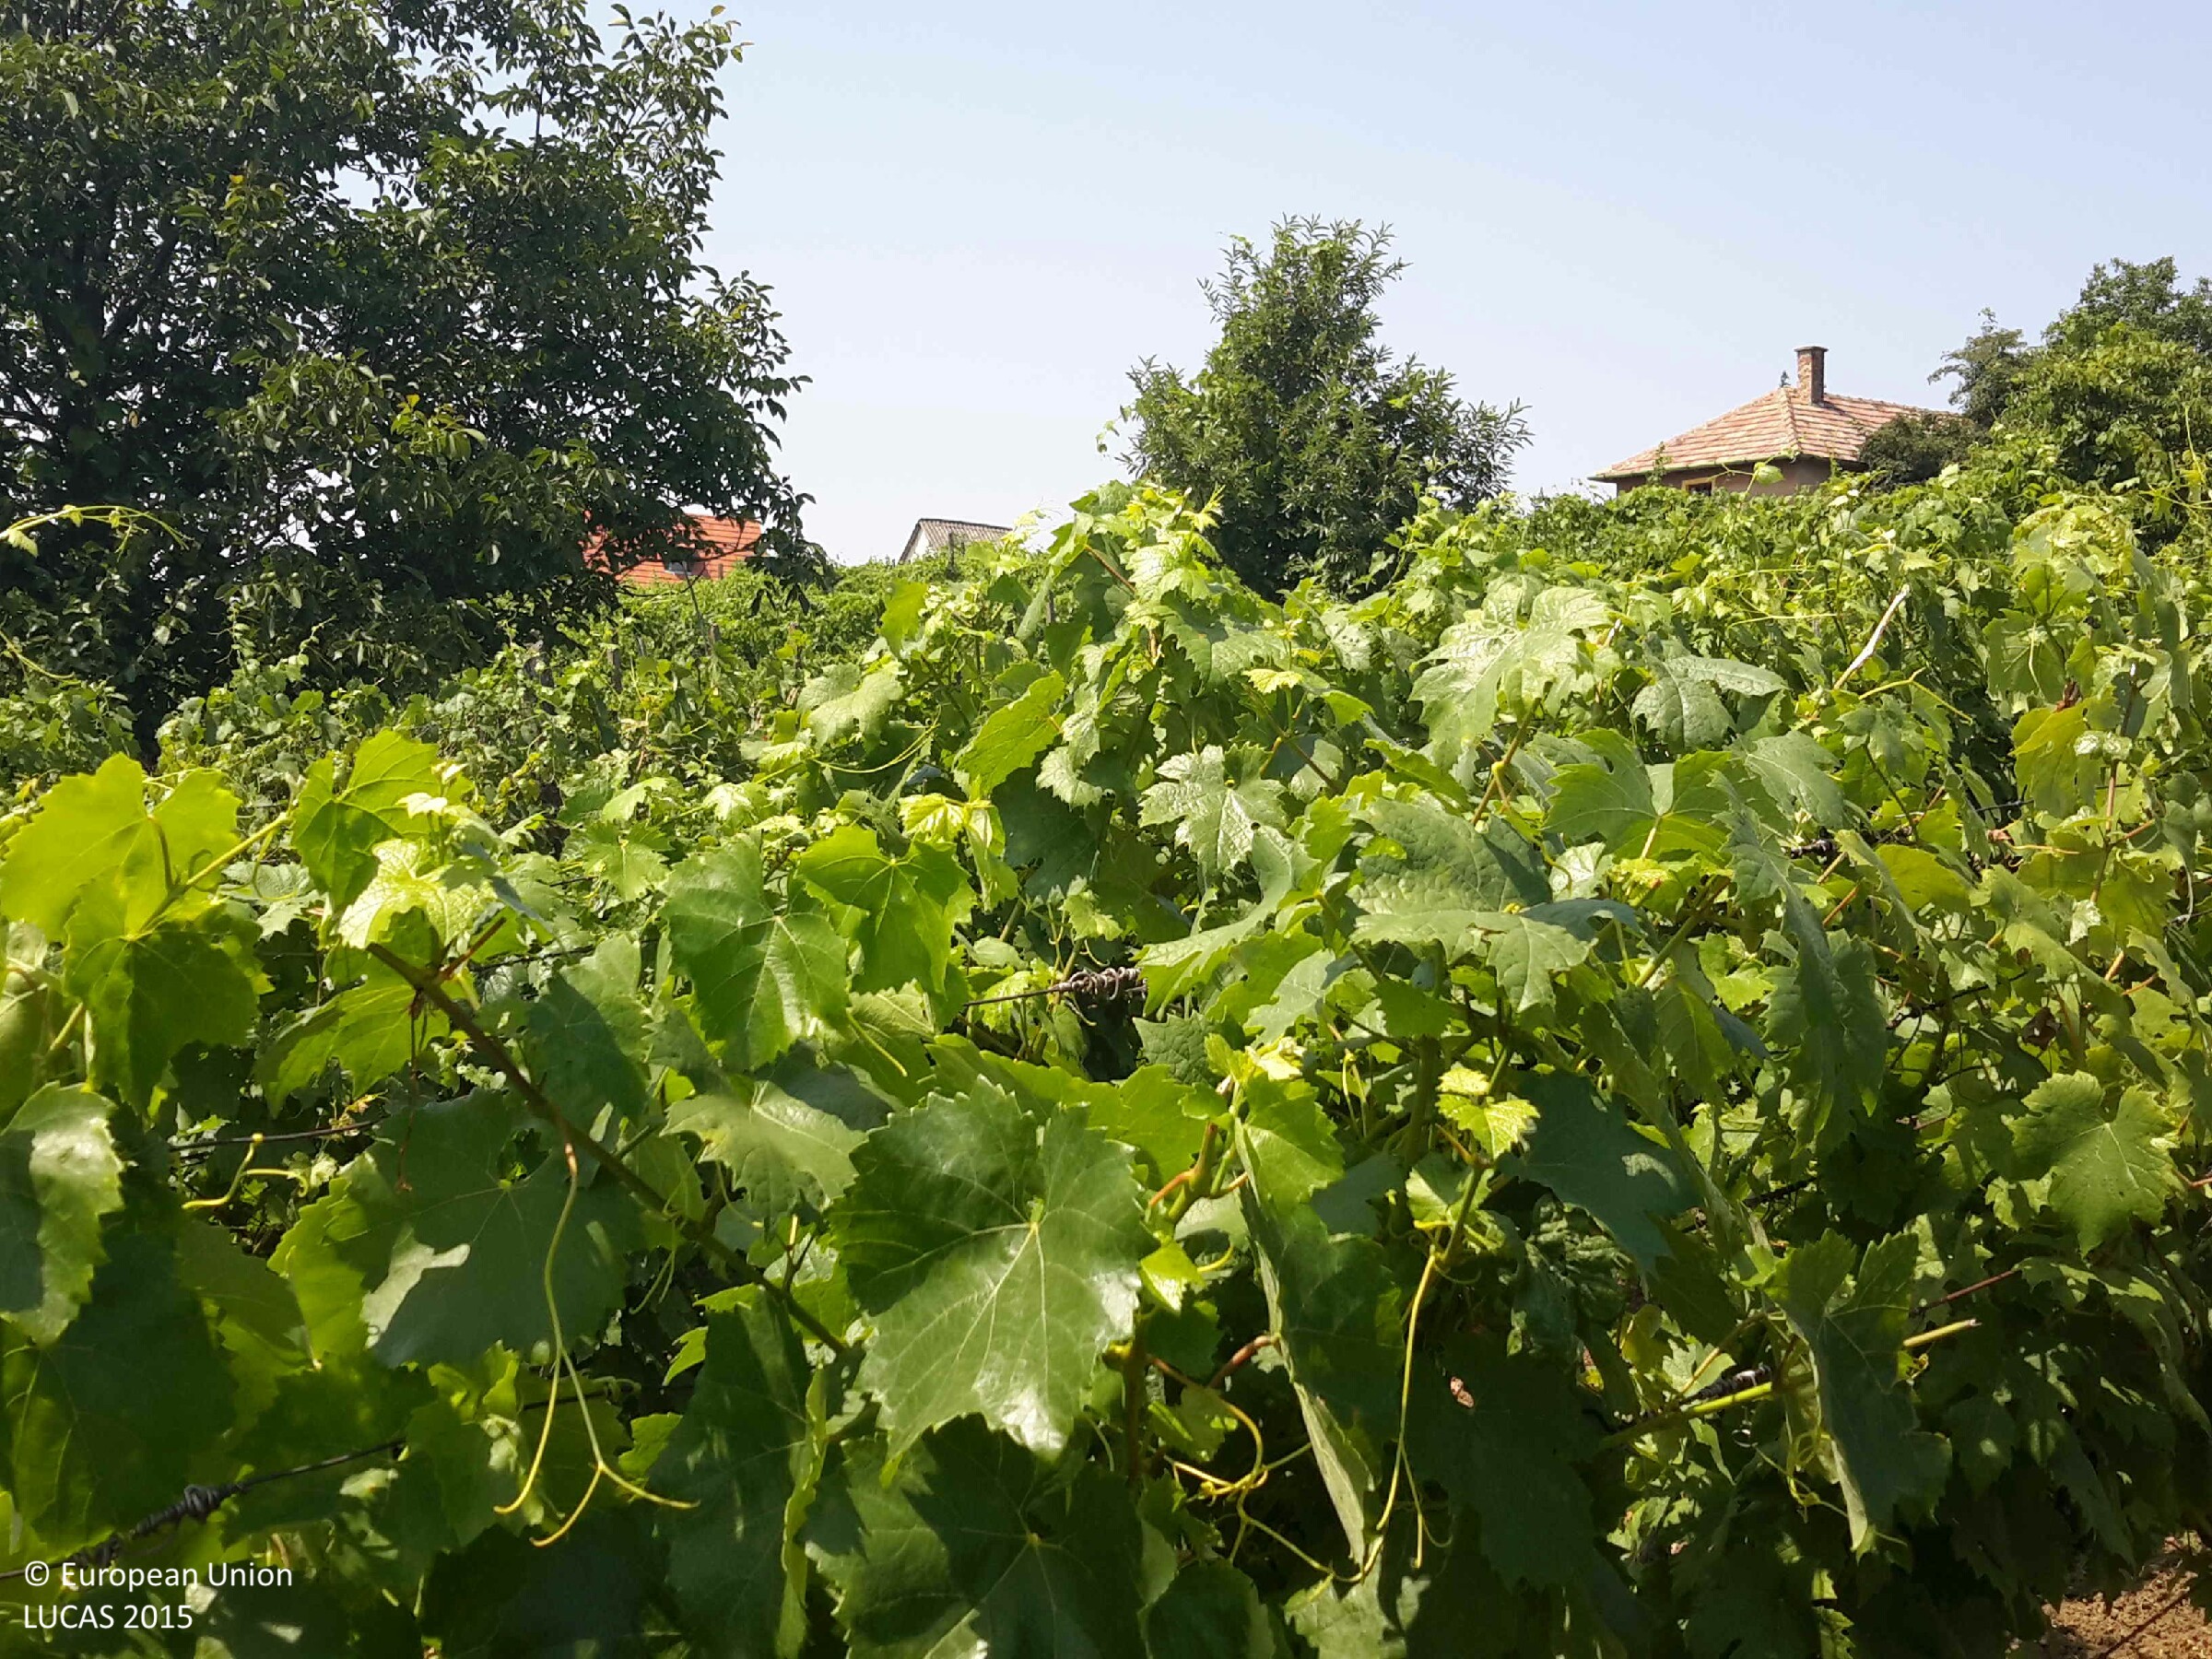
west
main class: Cropland
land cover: Vineyards
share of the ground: 25 - 50 %
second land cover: Other bare soil
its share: > 75 %
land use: Agriculture (excluding fallow land and kitchen gardens)
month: July
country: HU
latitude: 47.2213
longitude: 17.0438
